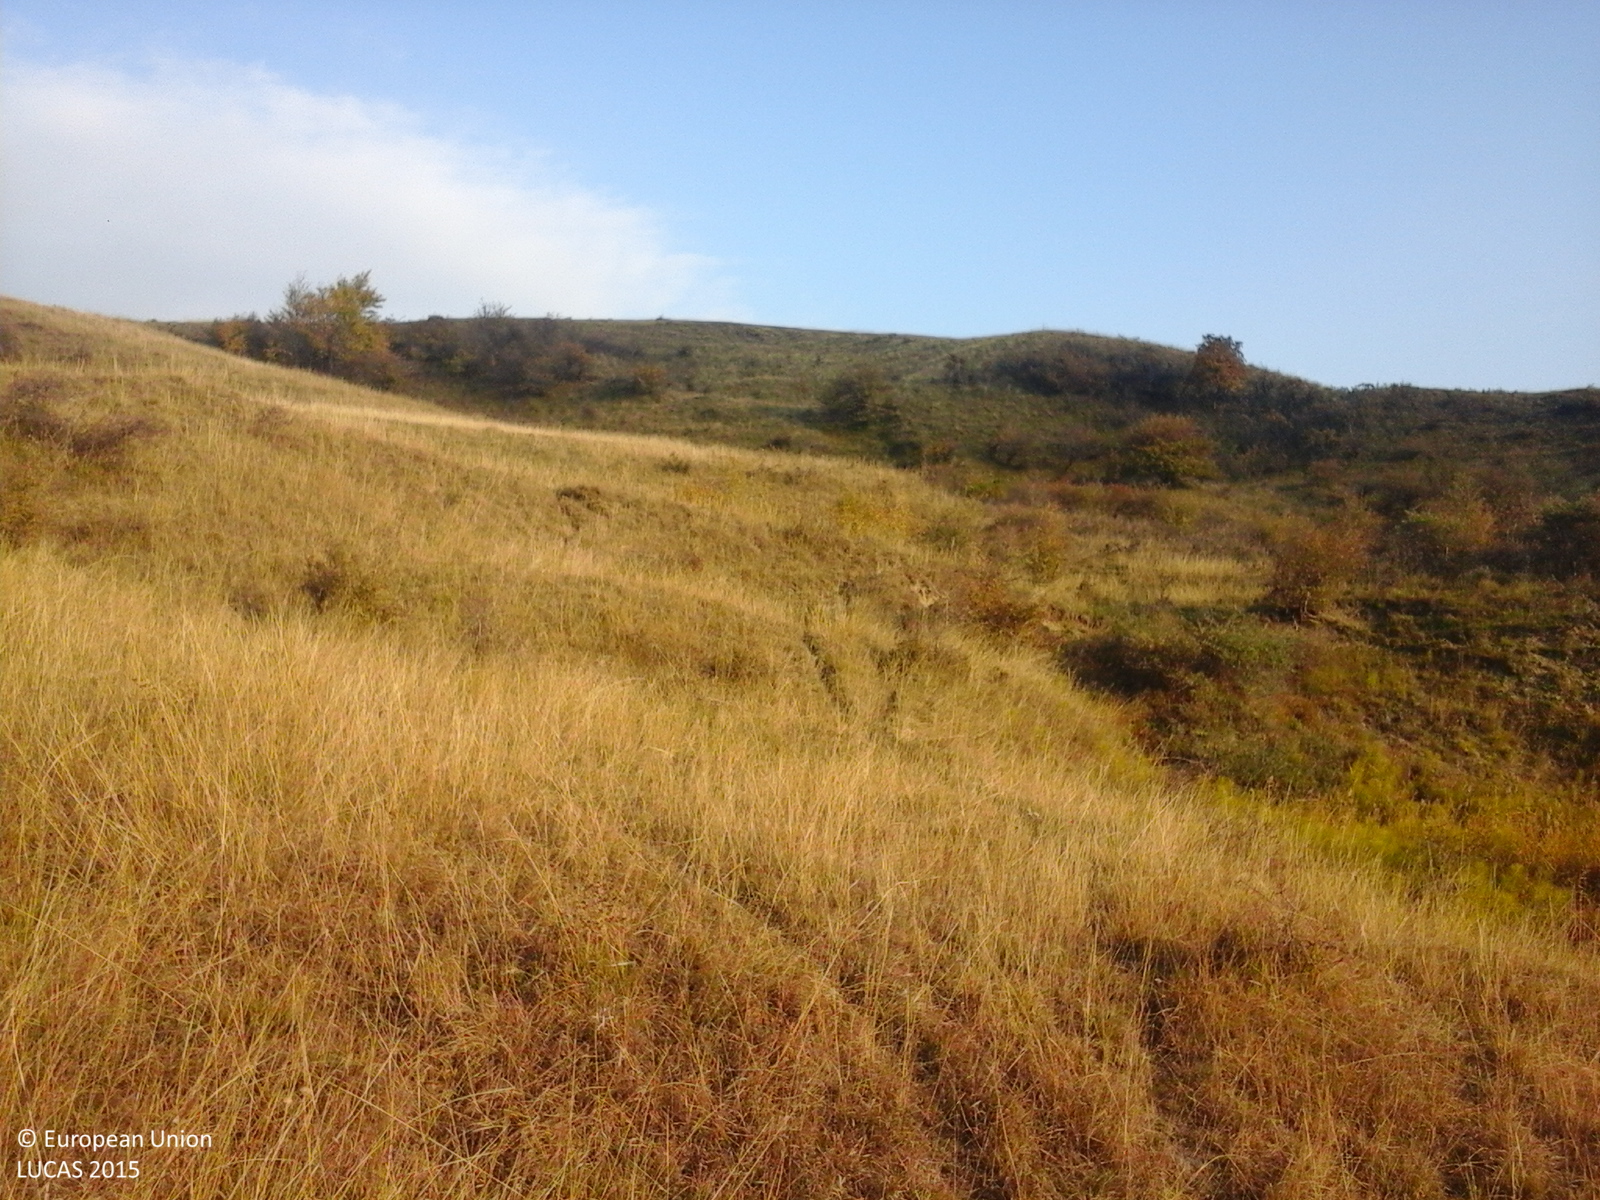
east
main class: Grassland
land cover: Grassland without tree/shrub cover
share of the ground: > 75 %
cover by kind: herbaceous plants 100 %
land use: Agriculture (excluding fallow land and kitchen gardens)
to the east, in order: Grassland without tree/shrub cover; Grassland with sparse tree/shrub cover; Grassland without tree/shrub cover; Grassland with sparse tree/shrub cover
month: October
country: RO
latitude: 45.4319
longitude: 26.5777
